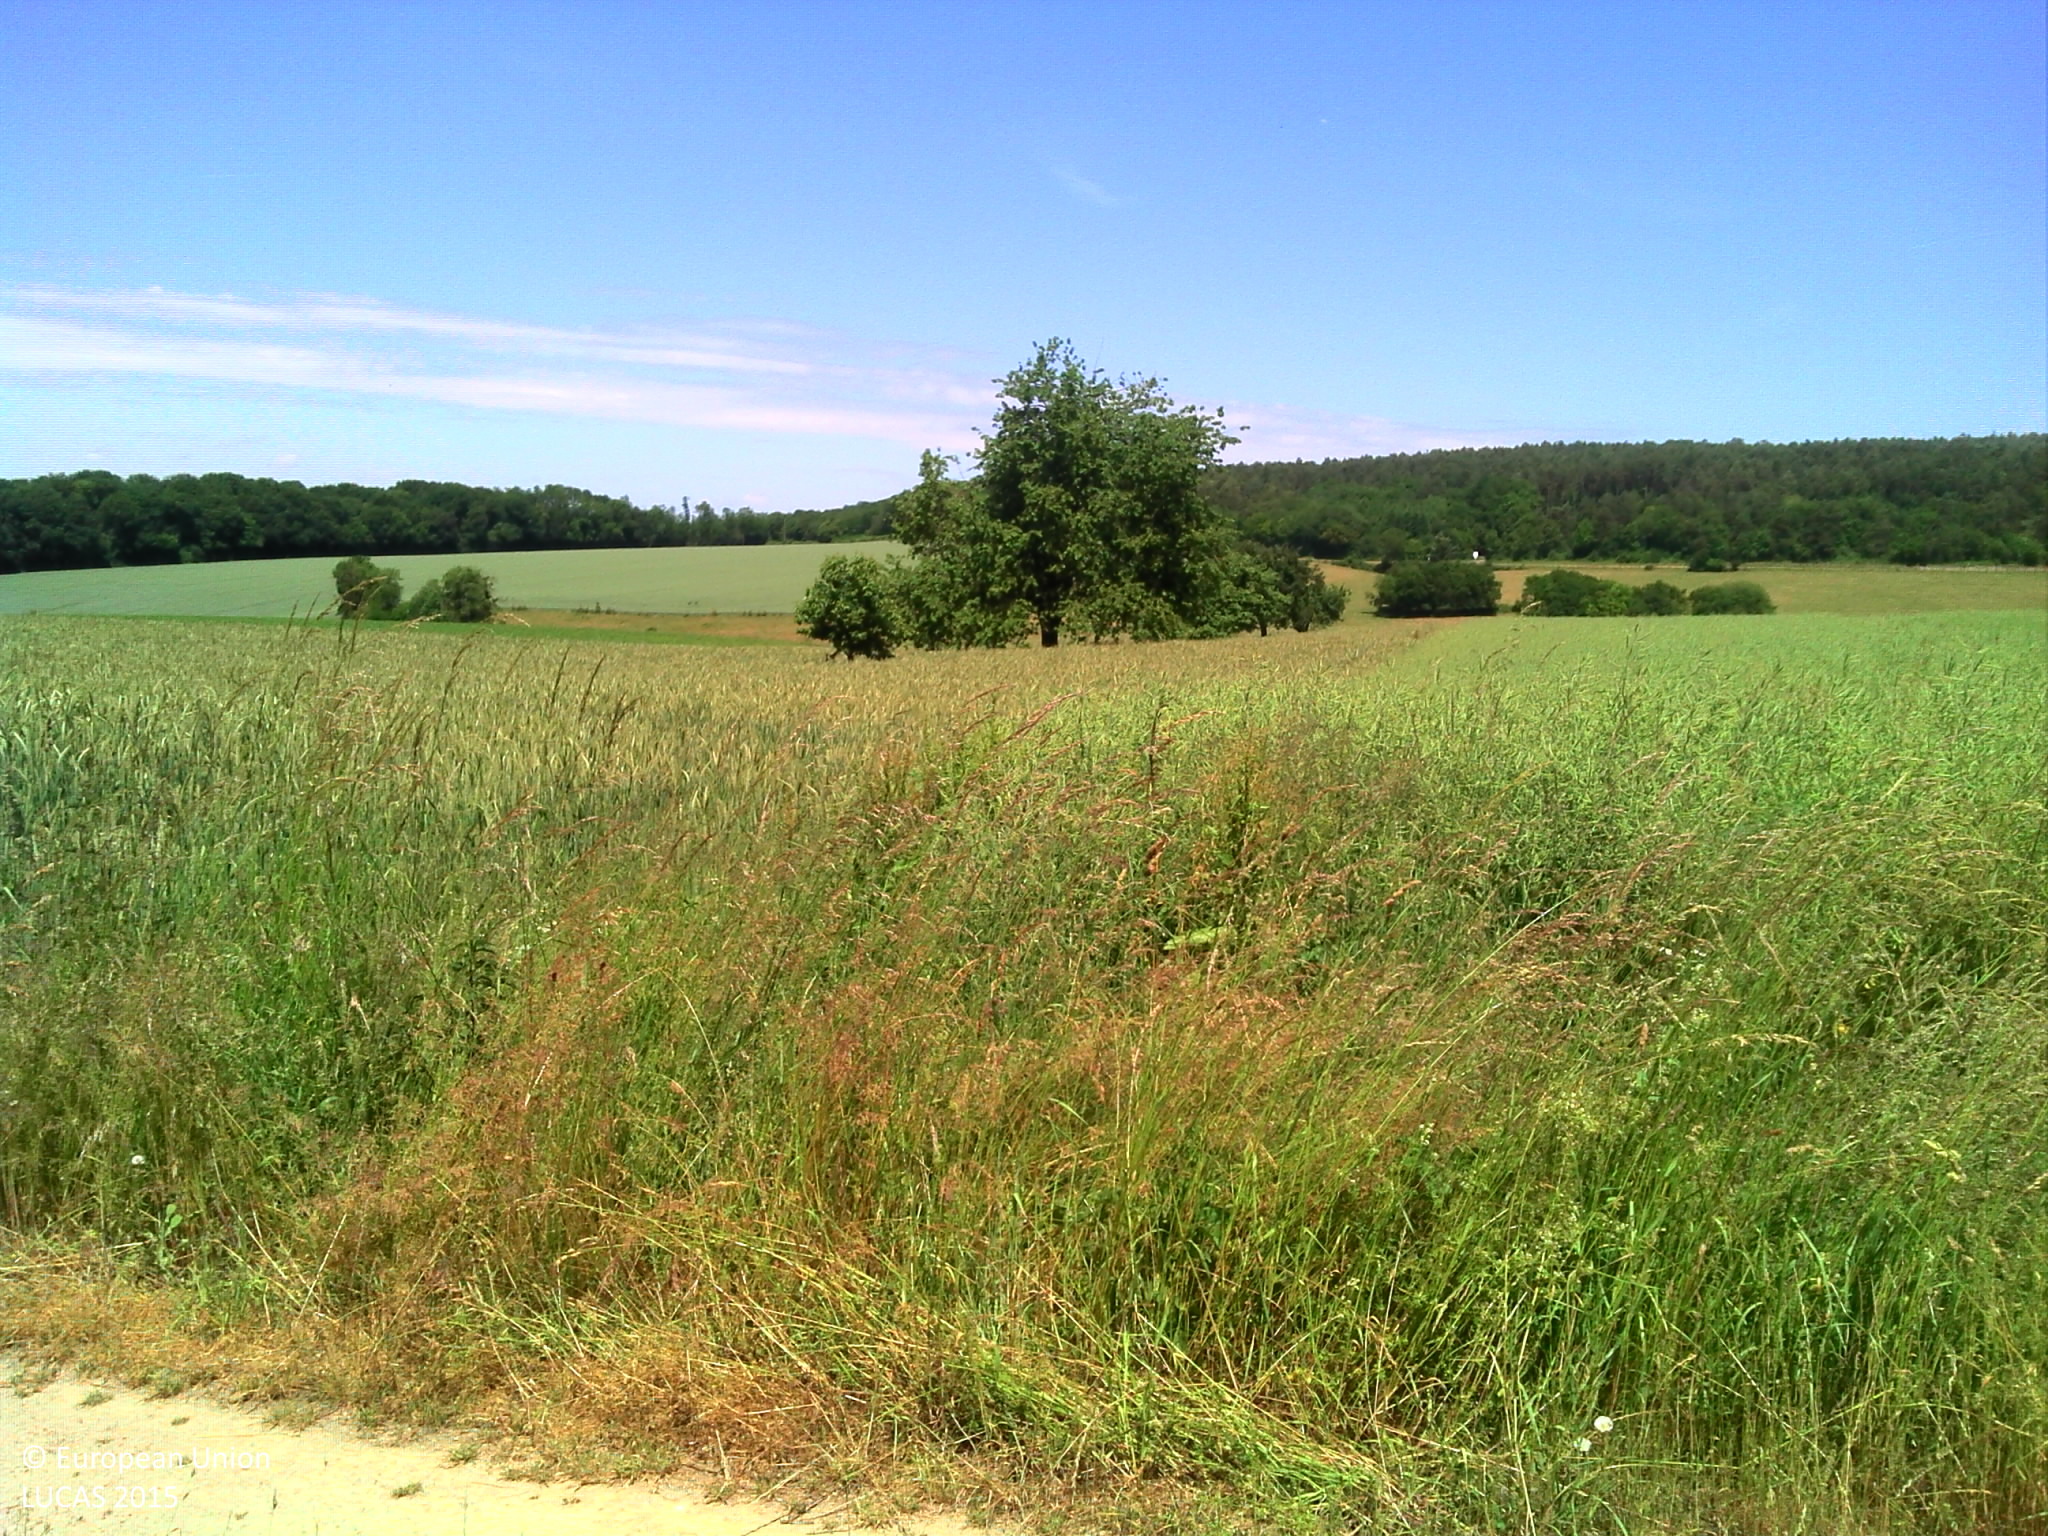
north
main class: Cropland
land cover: Rape and turnip rape
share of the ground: > 75 %
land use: Agriculture (excluding fallow land and kitchen gardens)
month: June
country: FR
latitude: 47.5394
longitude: 6.0290
